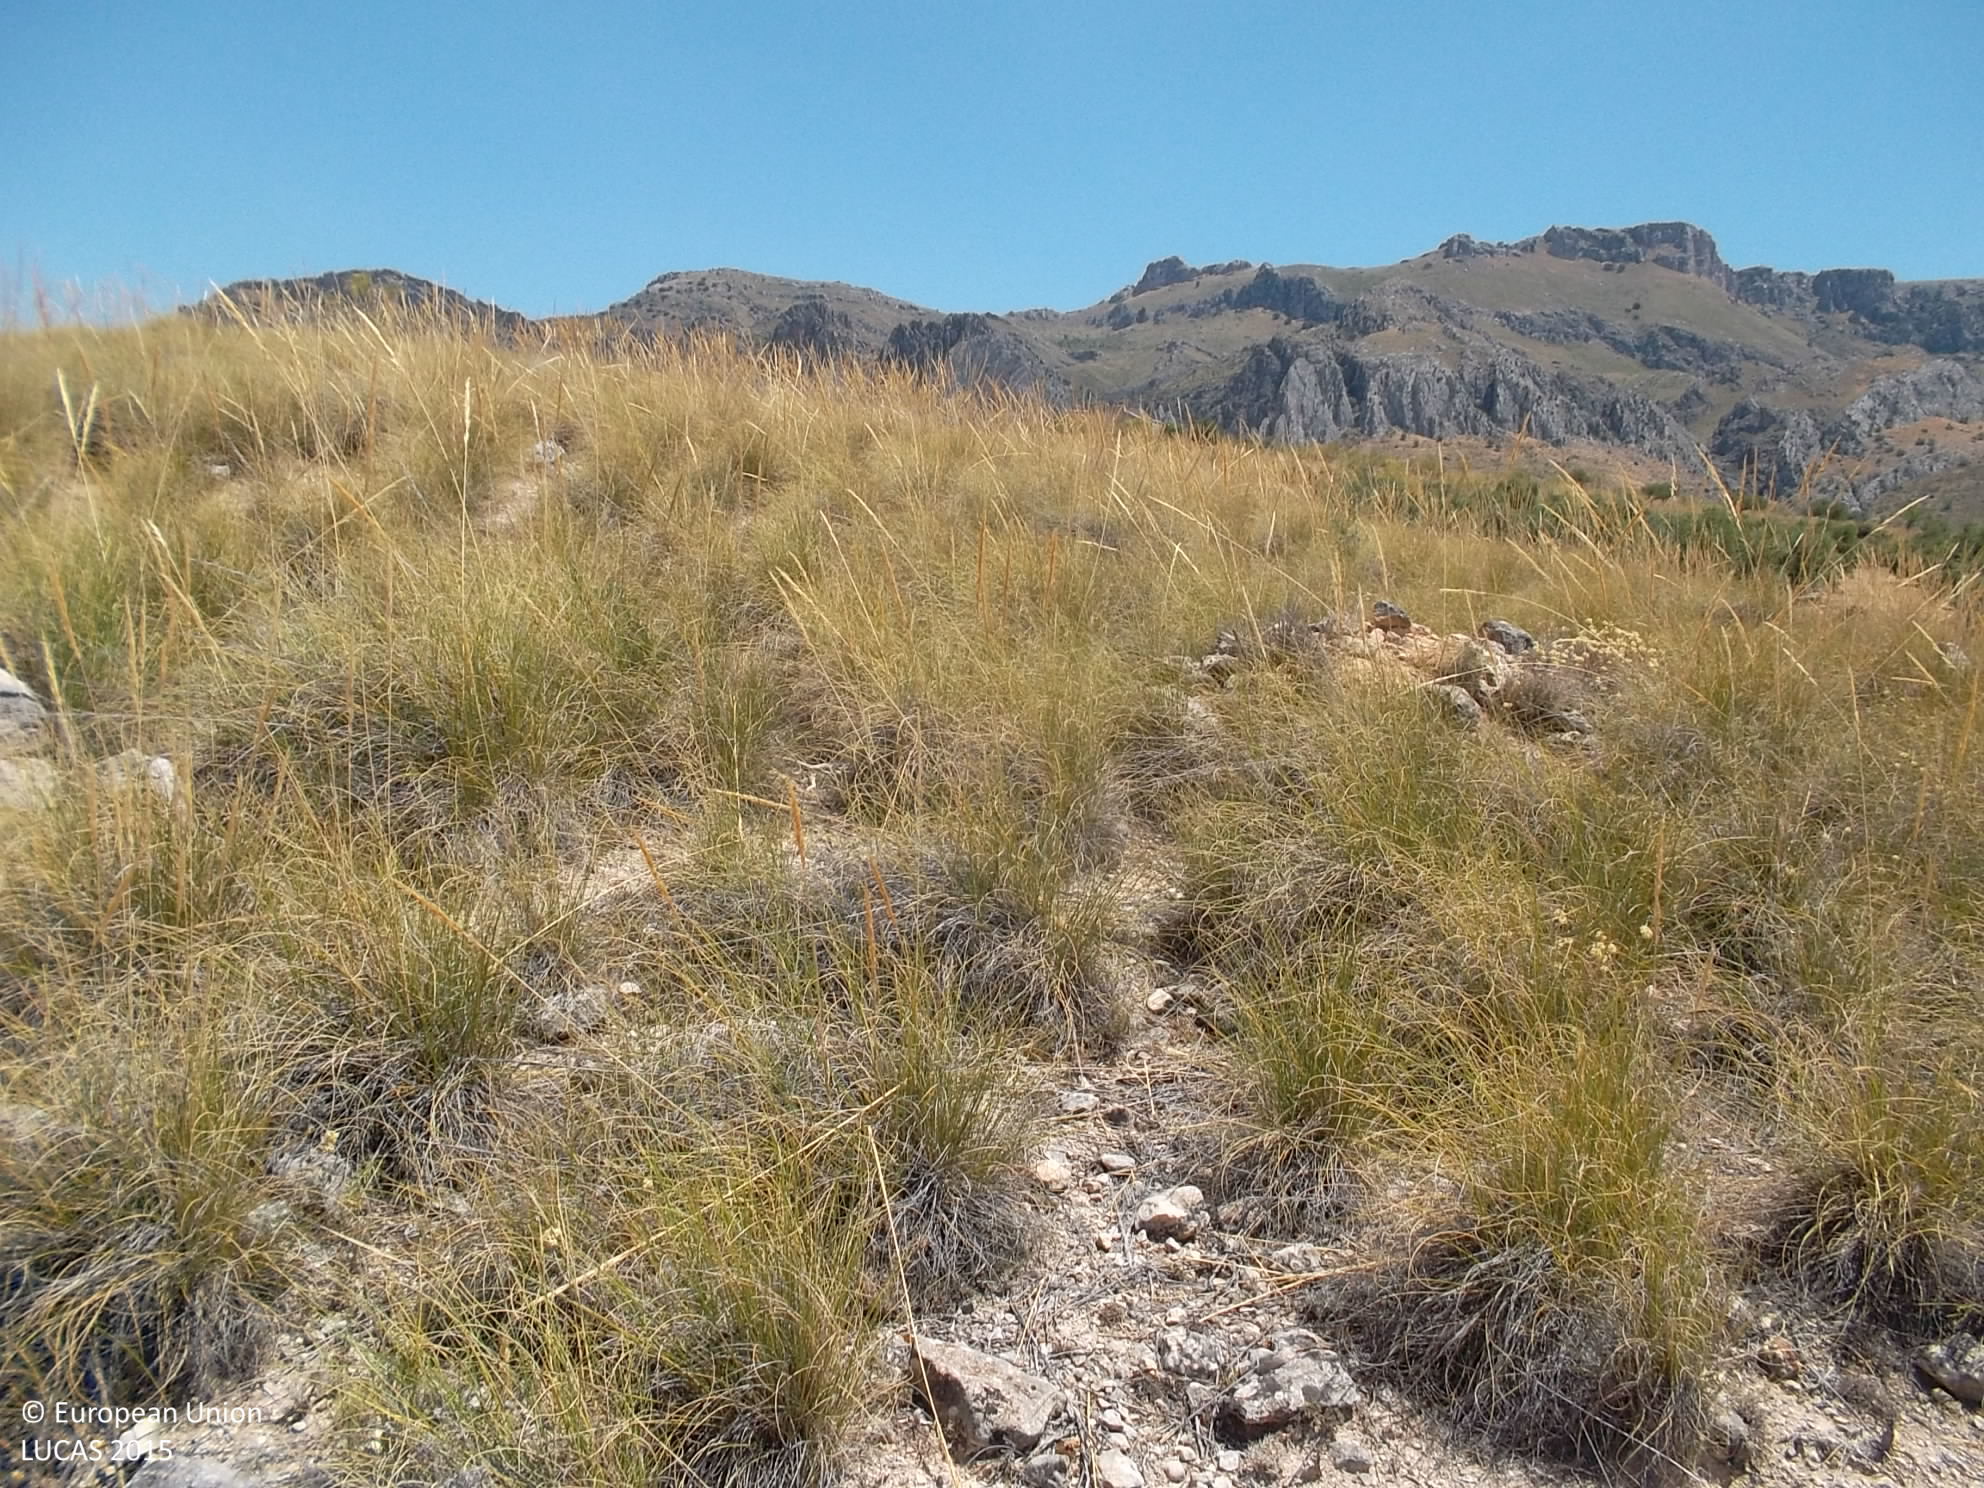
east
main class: Cropland
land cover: Olive groves
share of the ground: 25 - 50 %
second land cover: Other bare soil
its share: > 75 %
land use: Agriculture (excluding fallow land and kitchen gardens)
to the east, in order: Olive groves; Other bare soil; Grassland without tree/shrub cover; Shrubland without tree cover; Grassland without tree/shrub cover; Olive groves
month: June
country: ES
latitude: 37.8590
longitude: -3.3988
